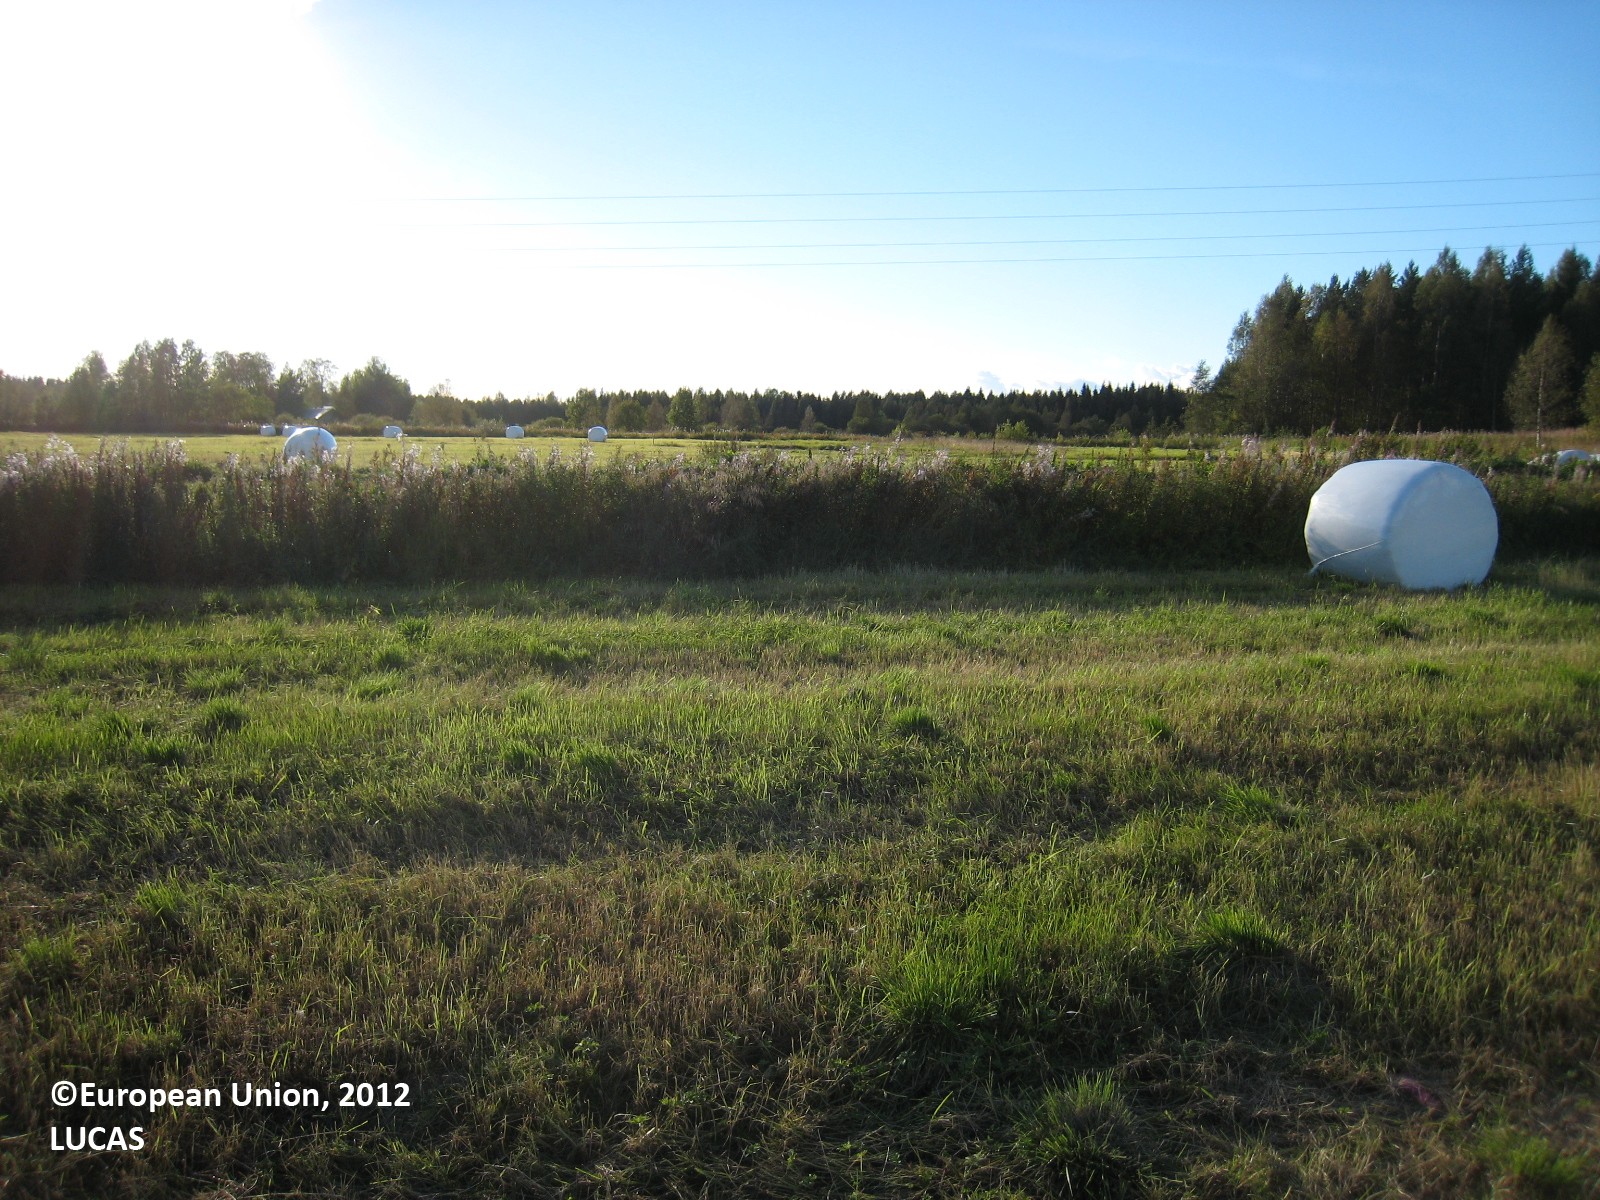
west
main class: Cropland
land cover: Temporary grasslands
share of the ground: > 75 %
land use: Agriculture (excluding fallow land and kitchen gardens)
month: September
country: FI
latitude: 63.0982
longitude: 26.8407
